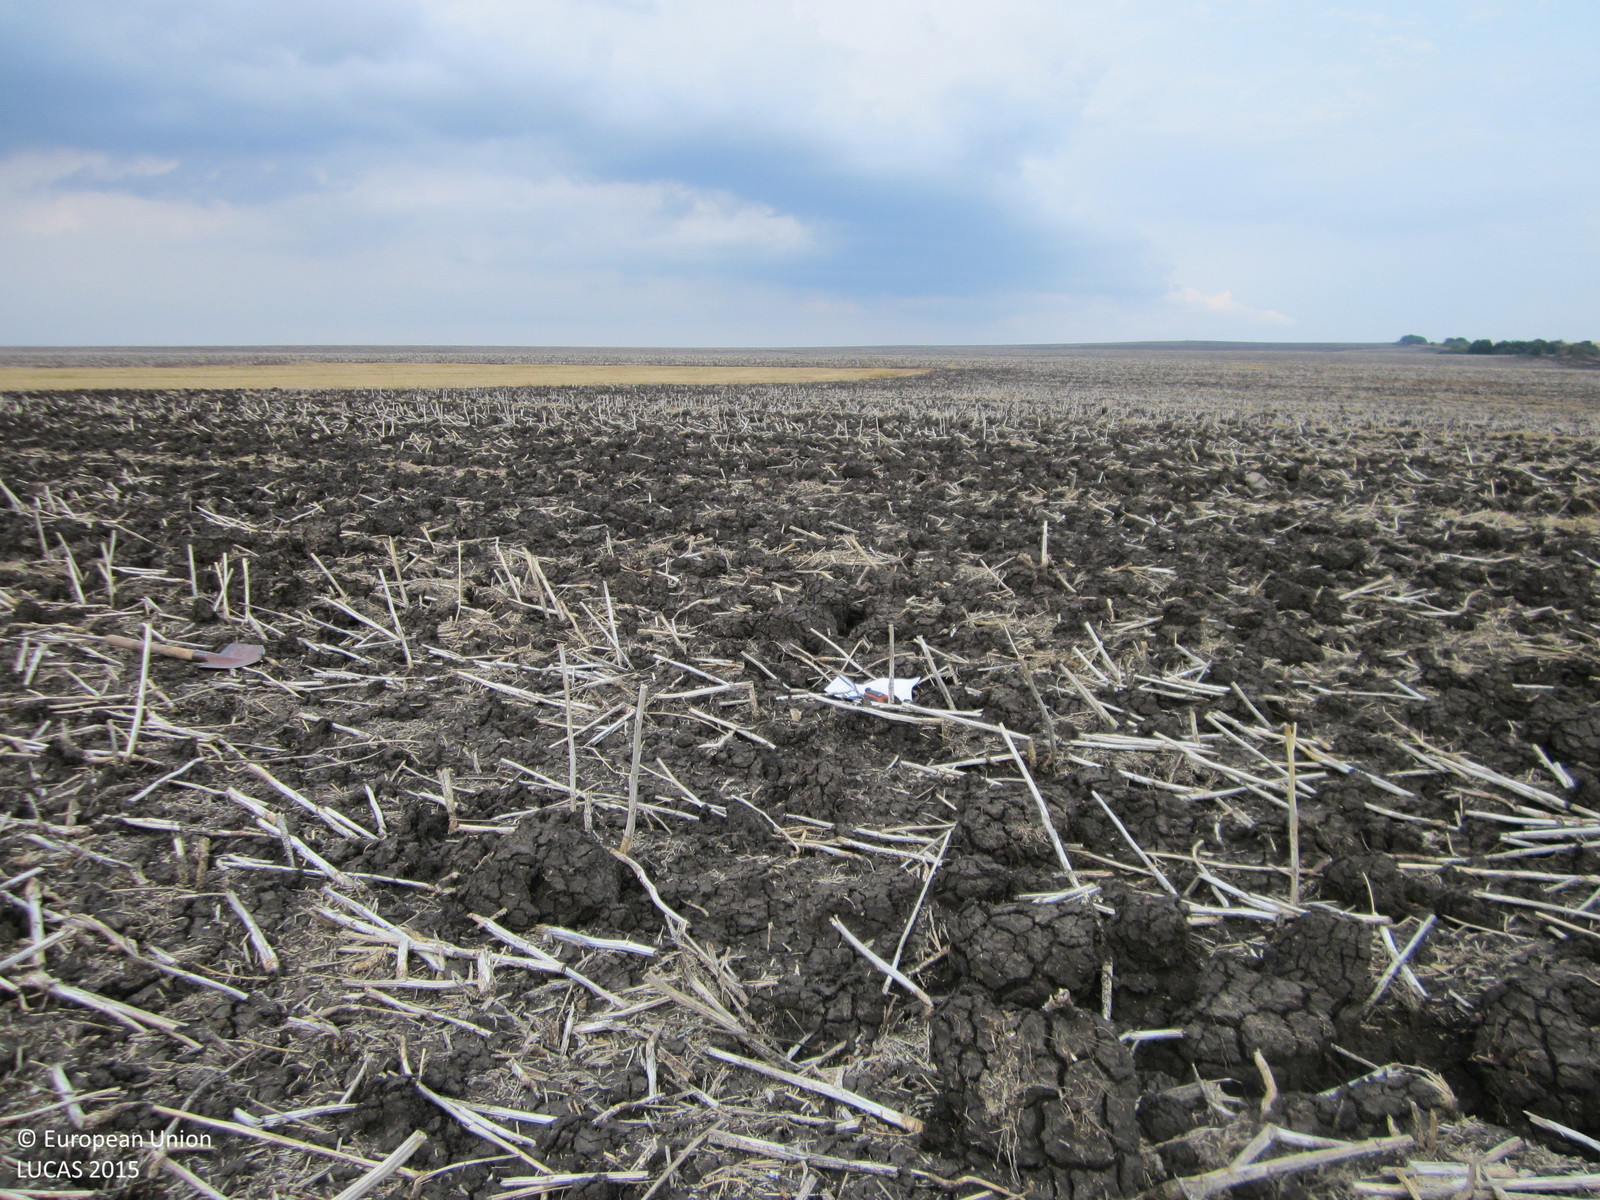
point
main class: Cropland
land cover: Sunflower
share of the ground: 10 - 25 %
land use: Agriculture (excluding fallow land and kitchen gardens)
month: August
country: BG
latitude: 42.4575
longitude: 26.9946
